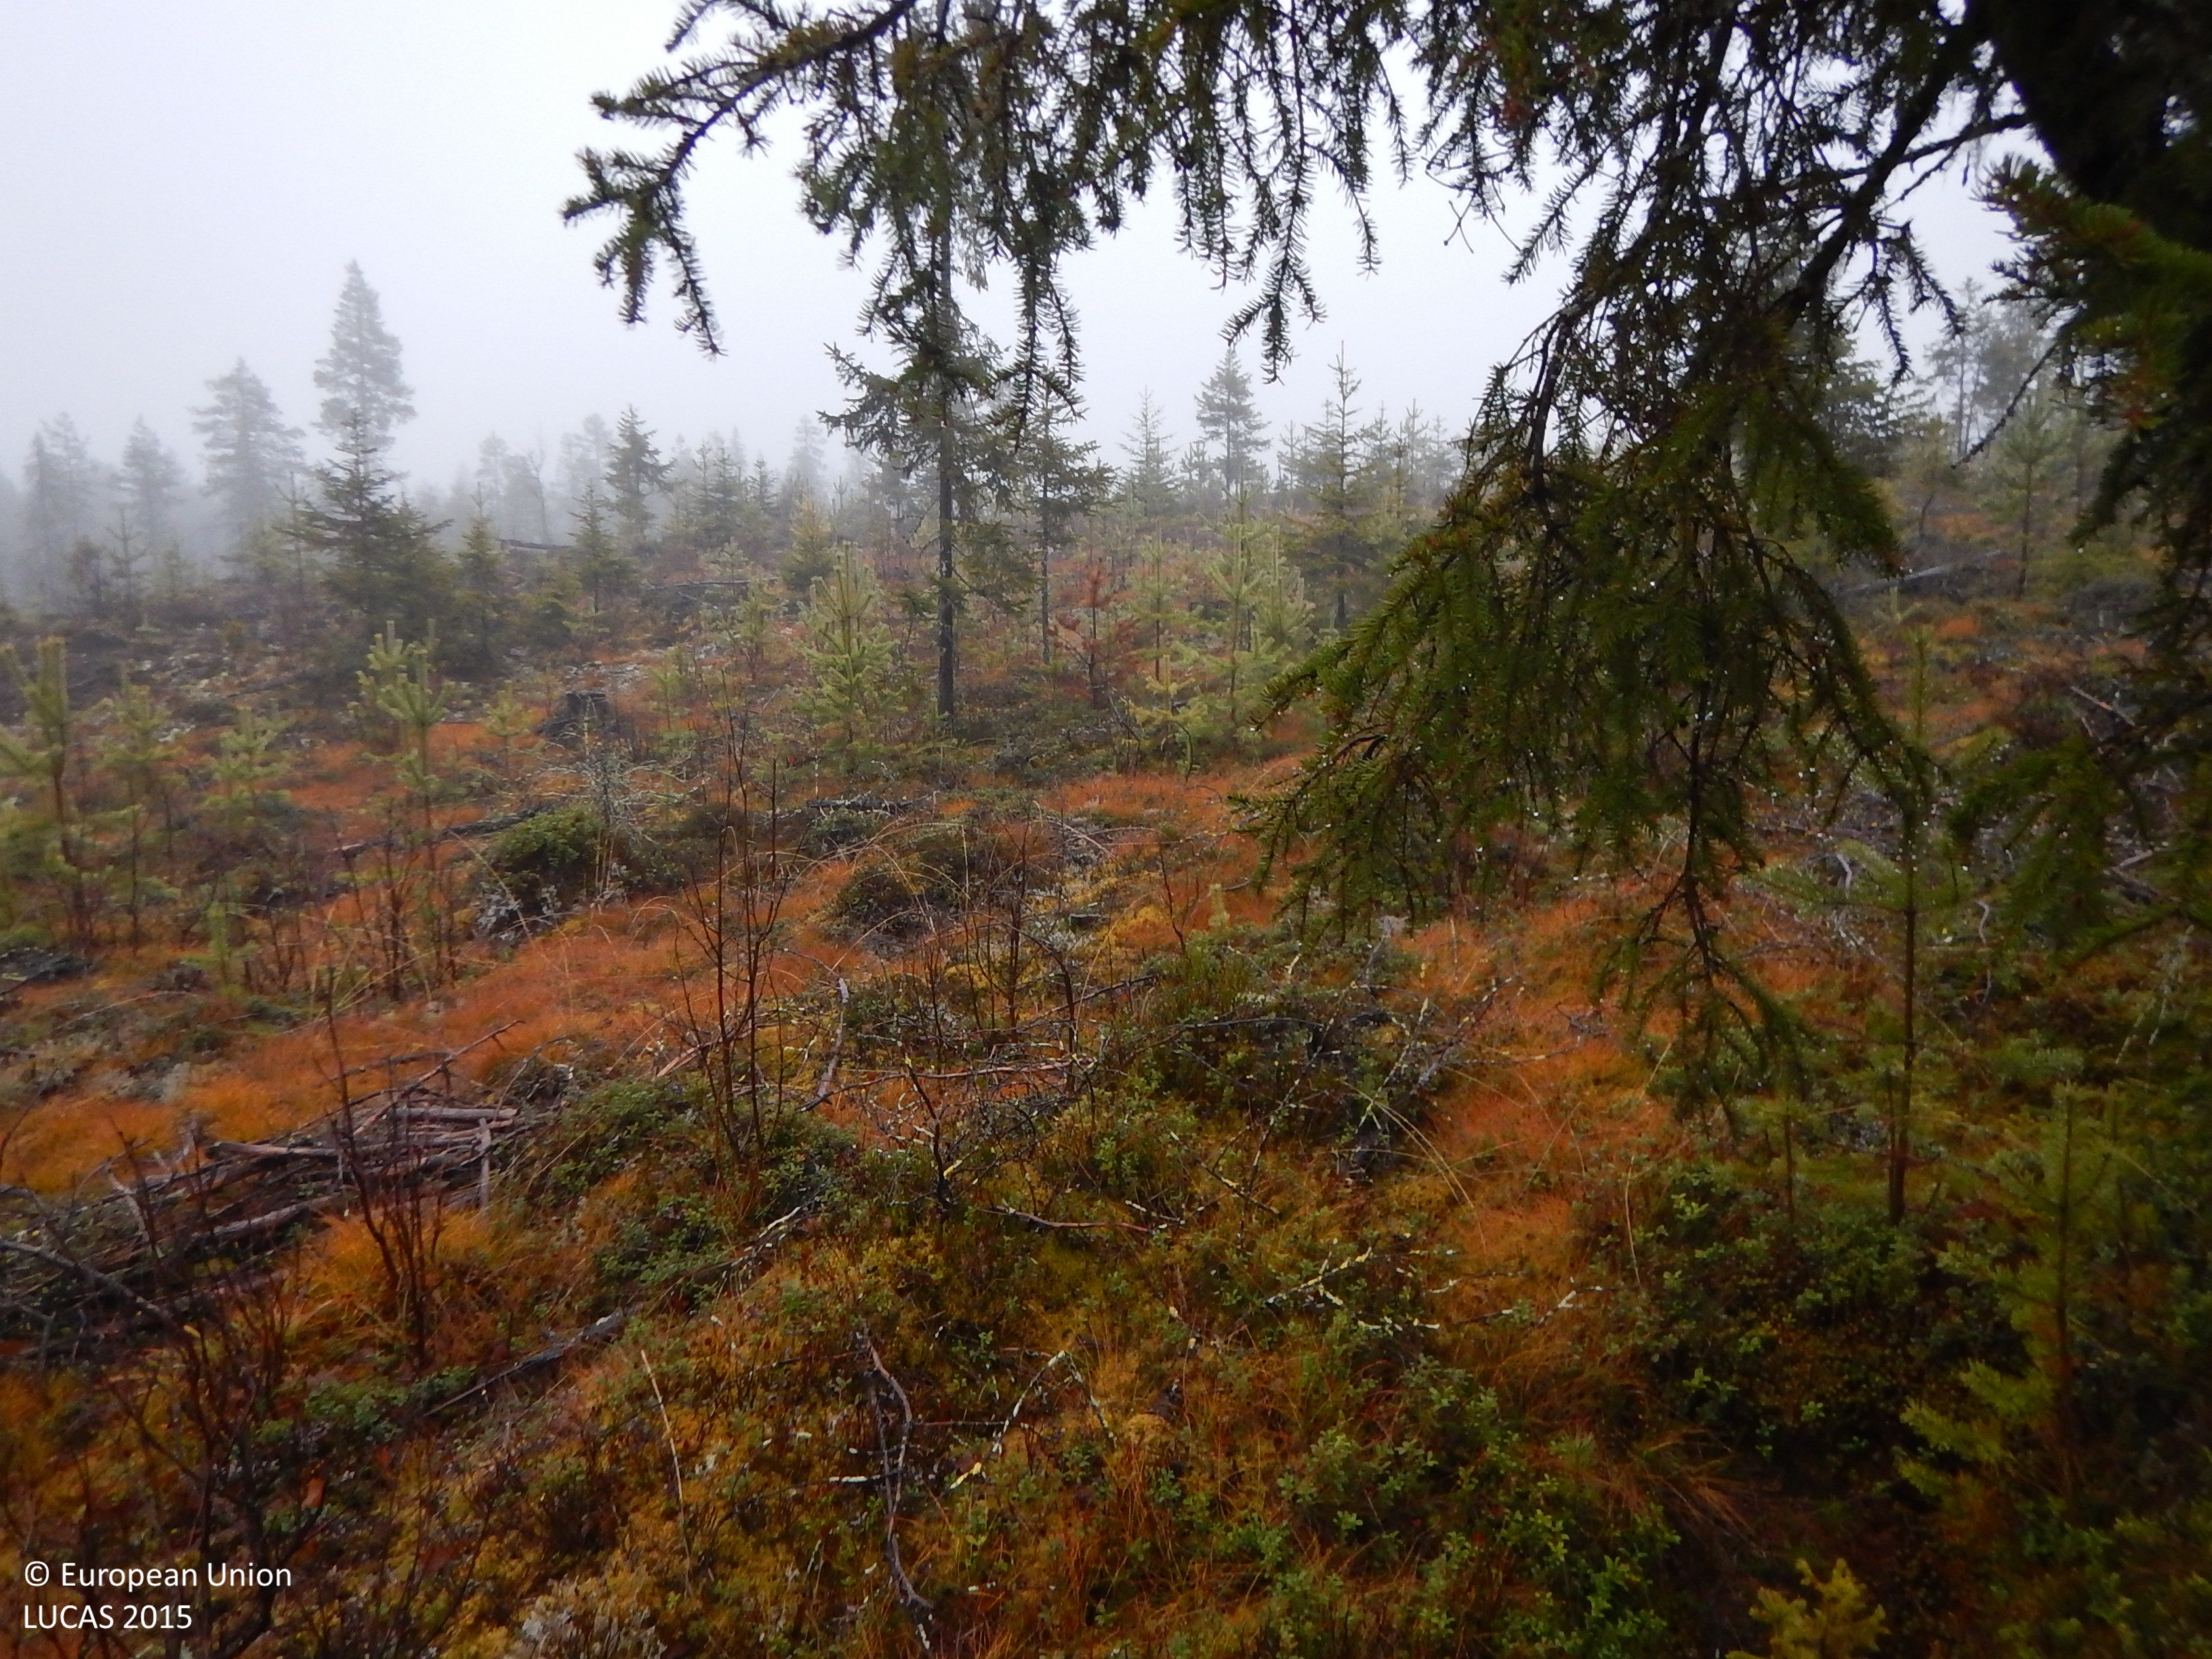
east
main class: Woodland
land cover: Pine dominated coniferous woodland
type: boreal forest
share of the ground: 25 - 50 %
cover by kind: shrubs 35 %, coniferous forest trees 20 %, lichens and mosses 20 %, herbaceous plants 15 %, broadleaved forest trees 5 %, consolidated bare surface 5 %
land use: Forestry
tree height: < 5 m
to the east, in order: Pine dominated coniferous woodland; Other coniferous woodland
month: November
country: SE
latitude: 65.0717
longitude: 20.4970
